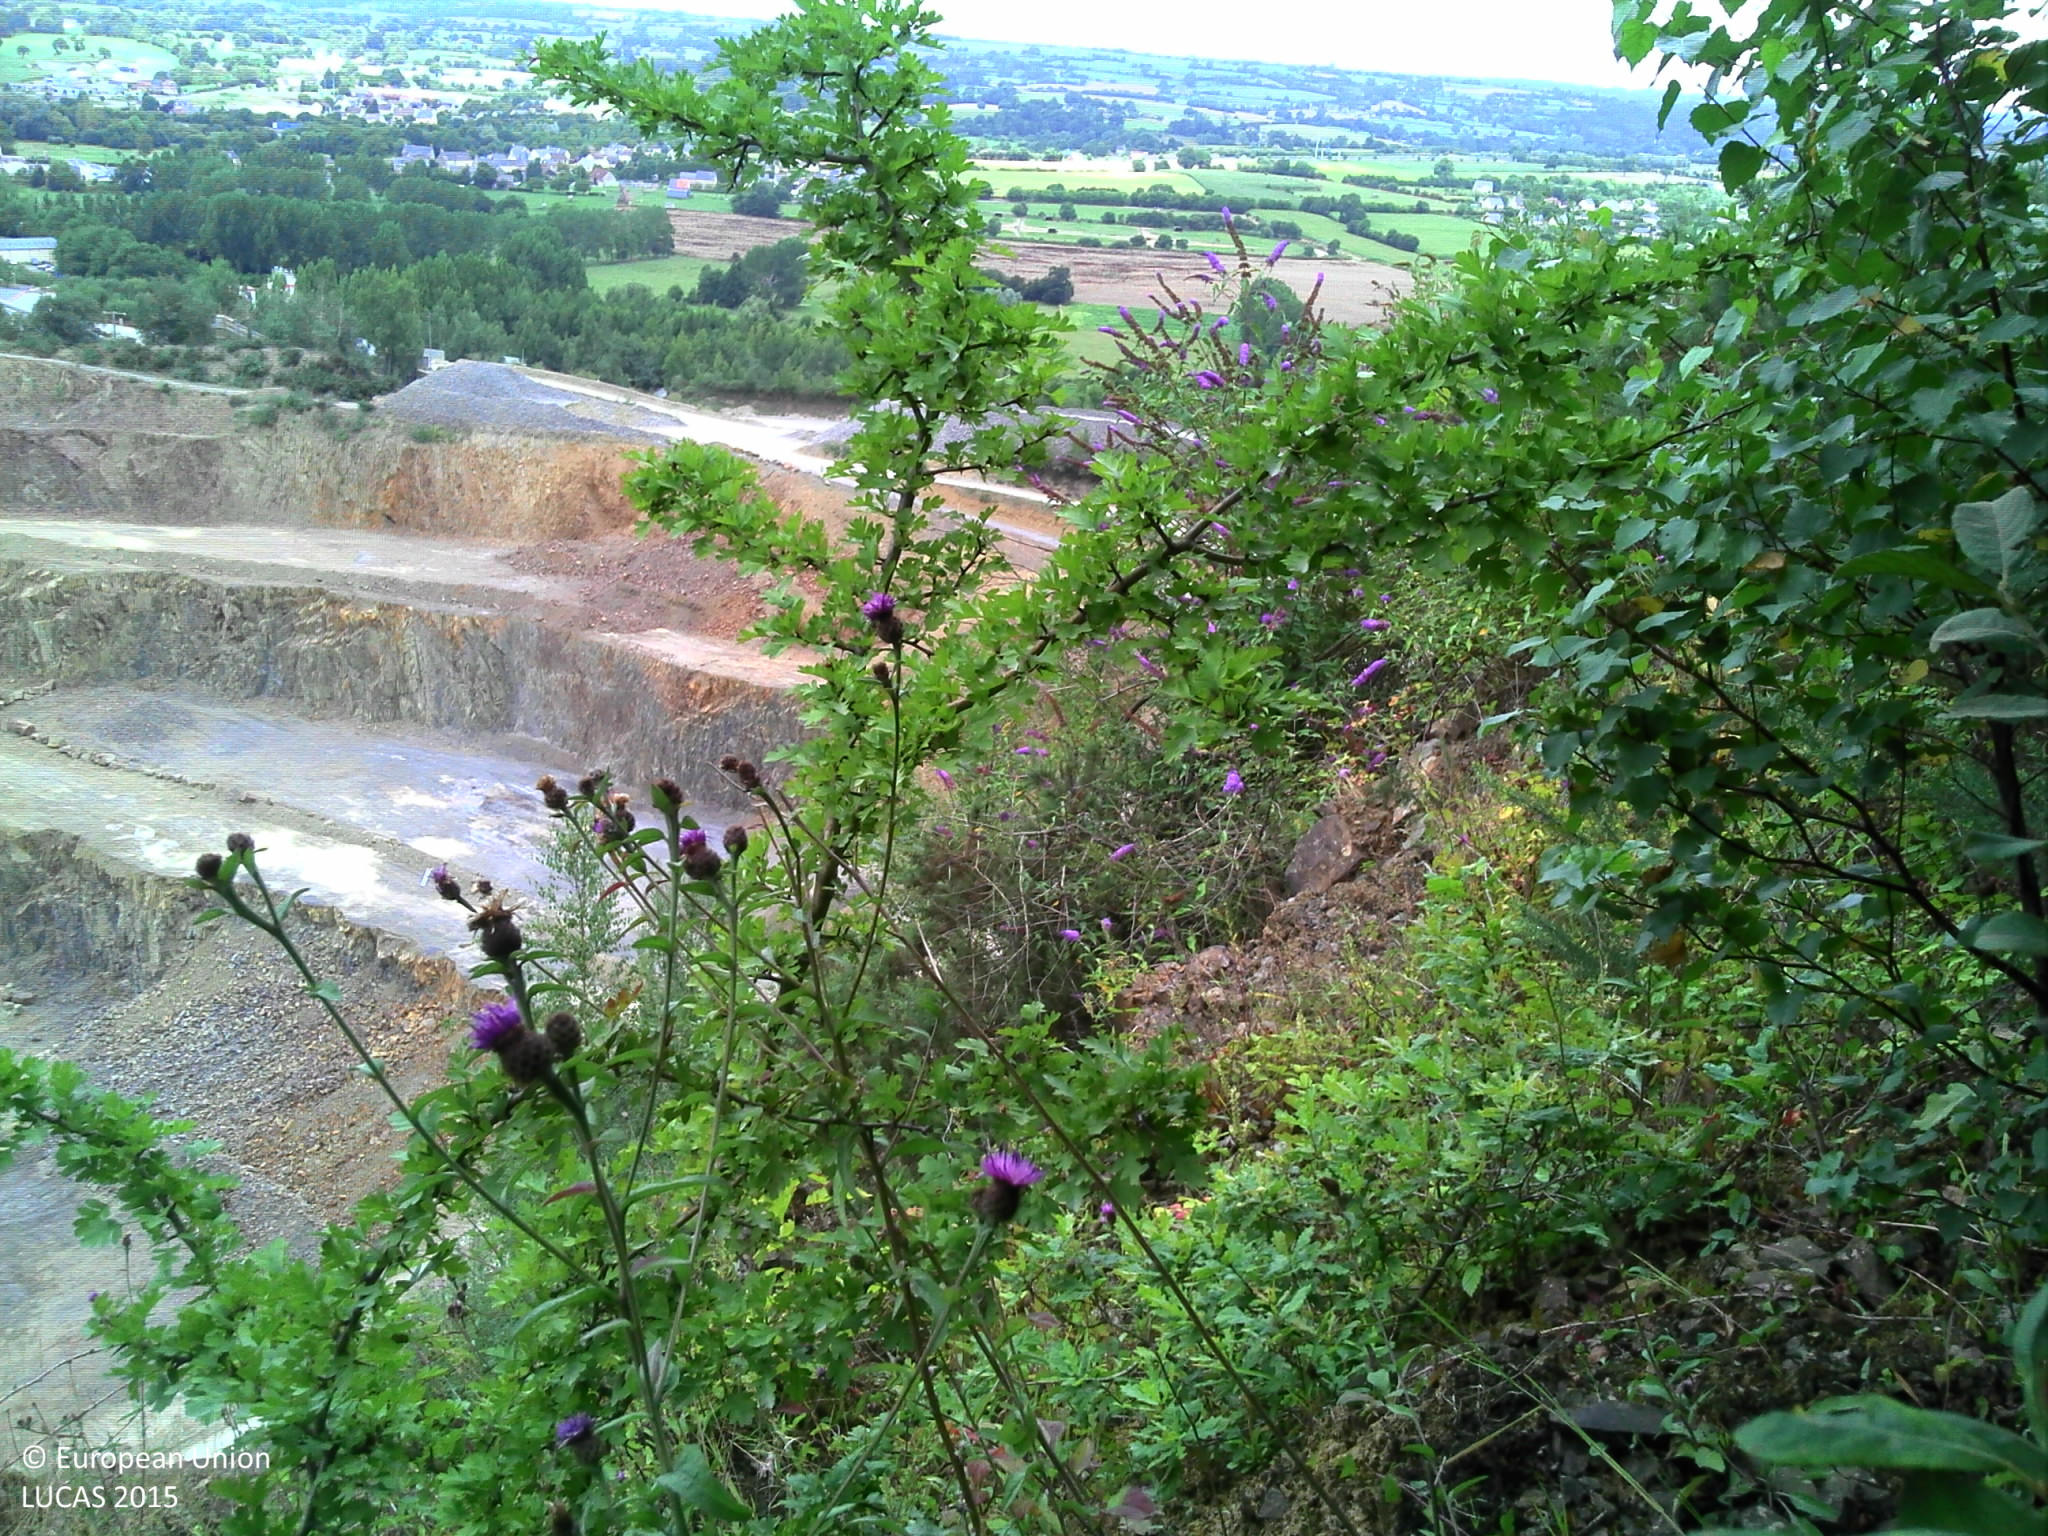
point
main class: Shrubland
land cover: Shrubland without tree cover
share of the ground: > 75 %
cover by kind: shrubs 50 %, herbaceous plants 50 %
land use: Semi-natural and natural areas not in use
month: August
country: FR
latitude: 48.6906
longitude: -1.3344
